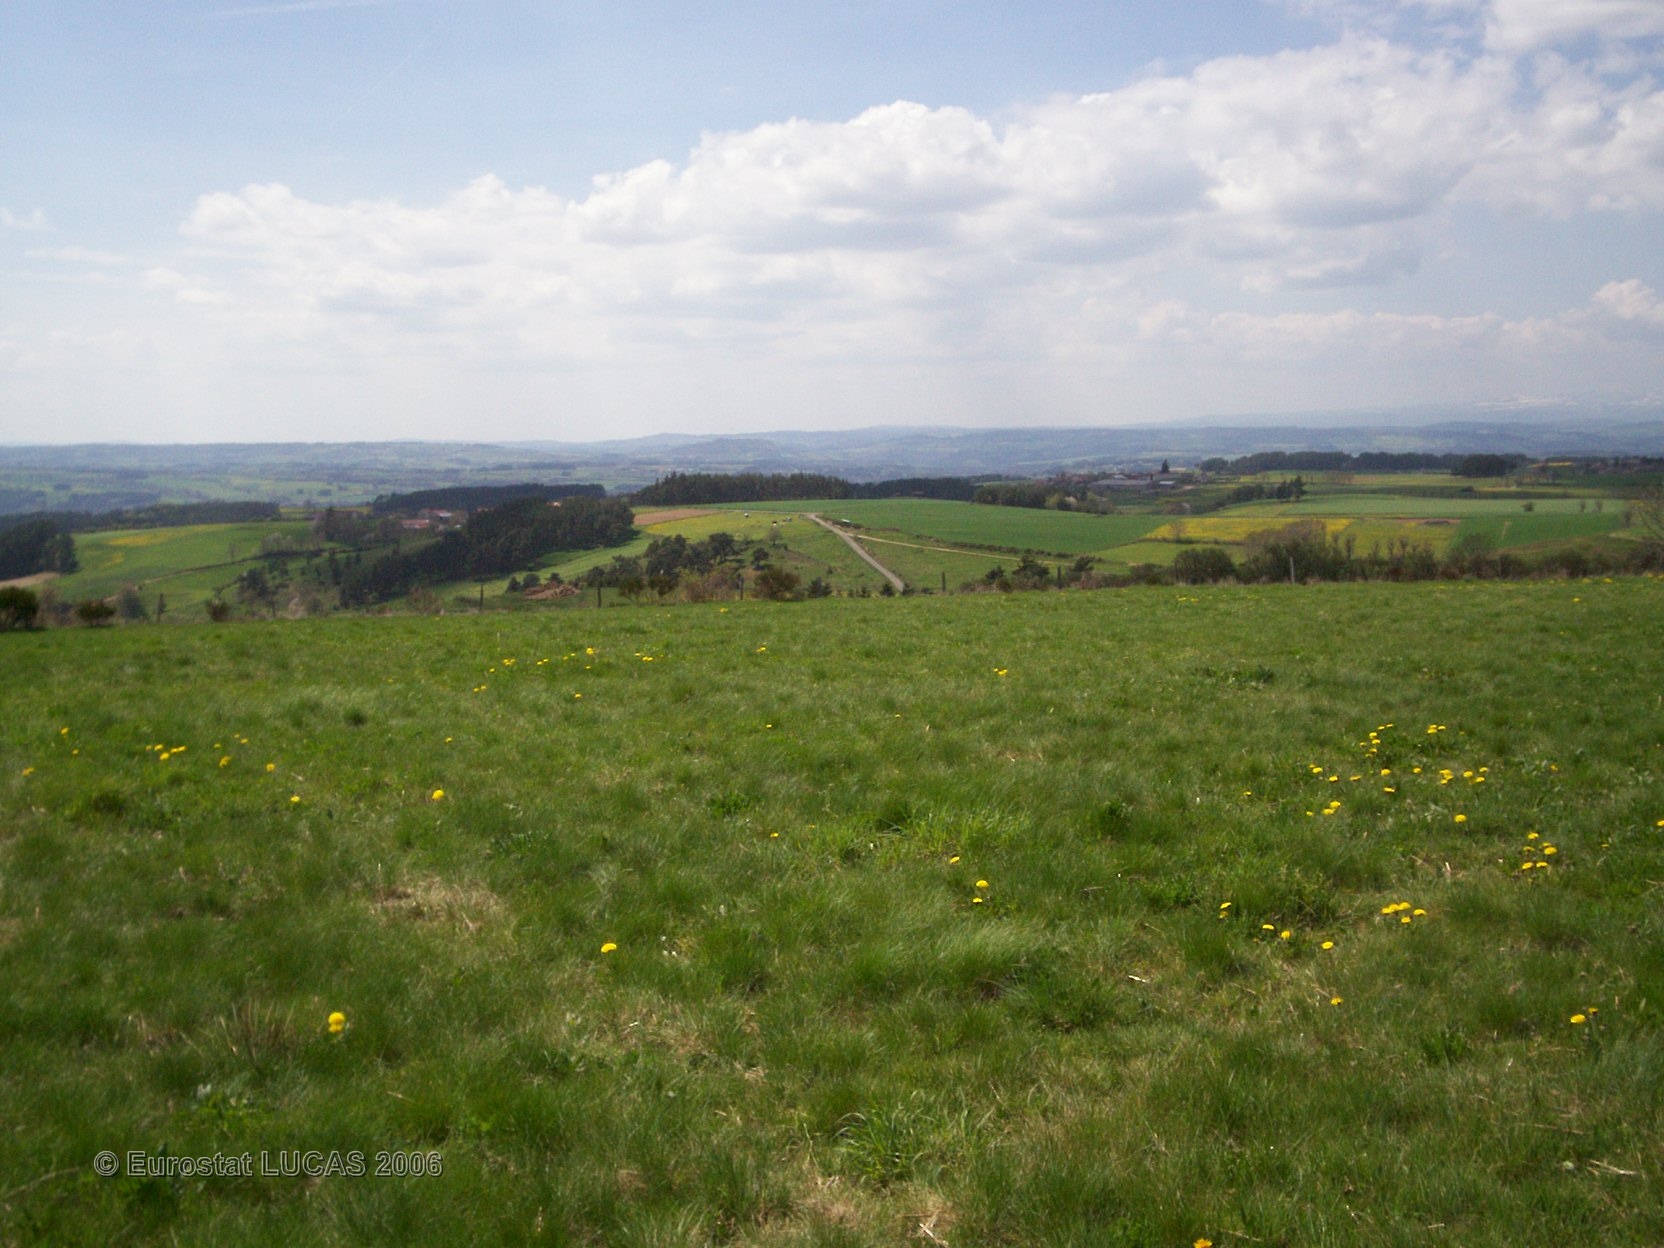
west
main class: Grassland
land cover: Grassland without tree/shrub cover
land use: Agriculture (excluding fallow land and kitchen gardens)
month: May
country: FR
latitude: 44.9821
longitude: 3.2689
